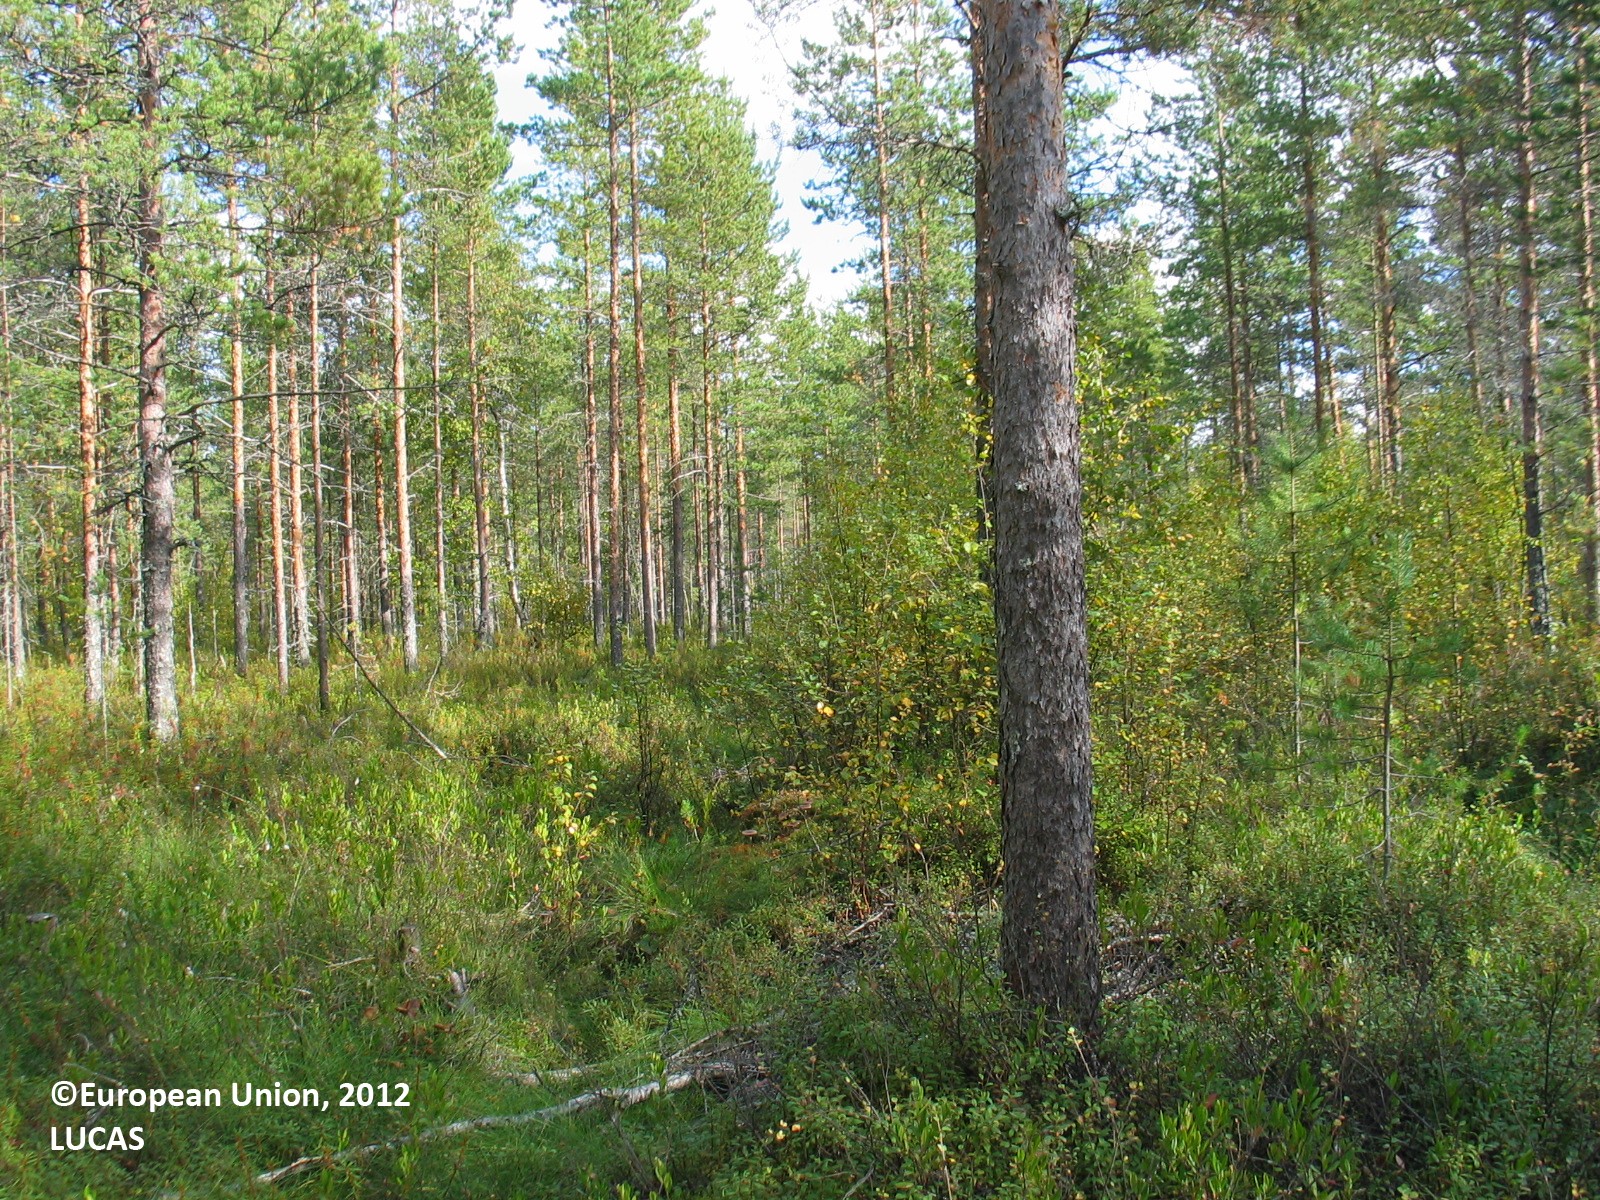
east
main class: Woodland
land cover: Pine dominated coniferous woodland
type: mire and swamp forests
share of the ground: 25 - 50 %
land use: Forestry
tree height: > 5 m
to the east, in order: Pine dominated coniferous woodland; Tracks; Pine dominated coniferous woodland; Shrubland without tree cover; Electric lines; Shrubland without tree cover; Pine dominated coniferous woodland
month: August
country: FI
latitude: 65.2394
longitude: 26.4300
